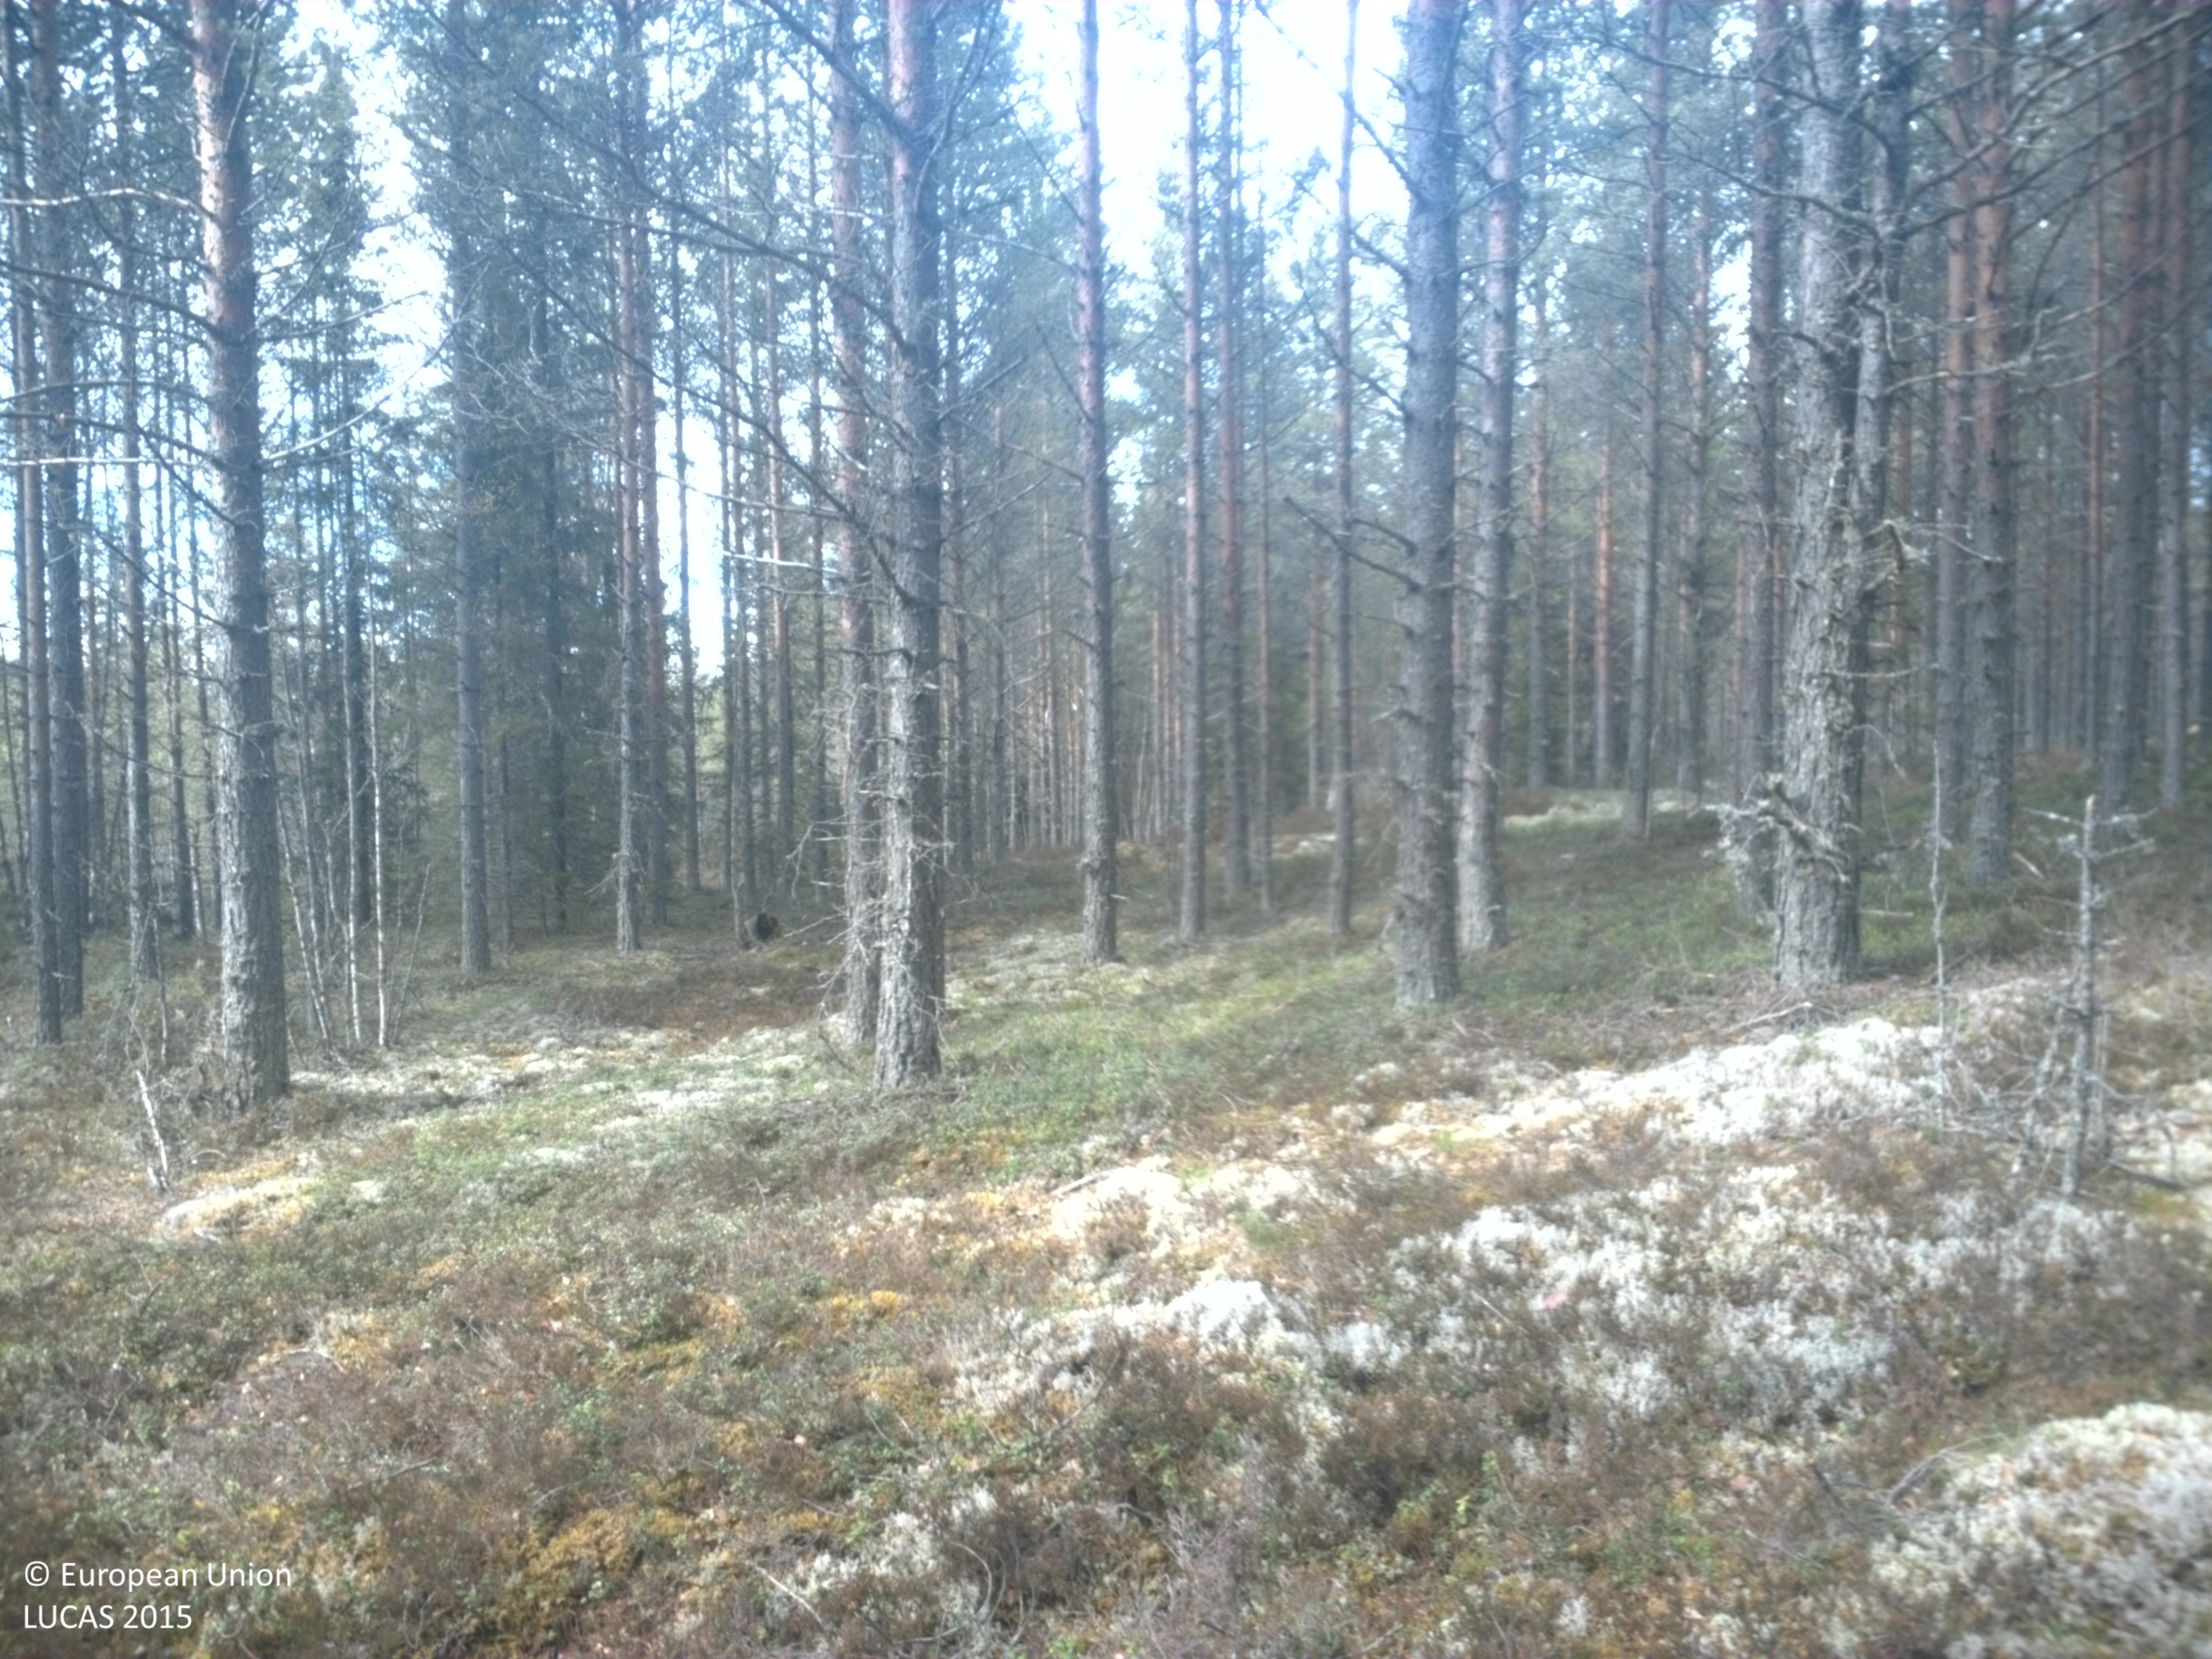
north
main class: Woodland
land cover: Pine dominated coniferous woodland
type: boreal forest
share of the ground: 50 - 75 %
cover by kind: coniferous forest trees 70 %, shrubs 20 %, lichens and mosses 10 %
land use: Forestry
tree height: > 5 m
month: June
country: SE
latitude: 61.0422
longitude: 13.3401
